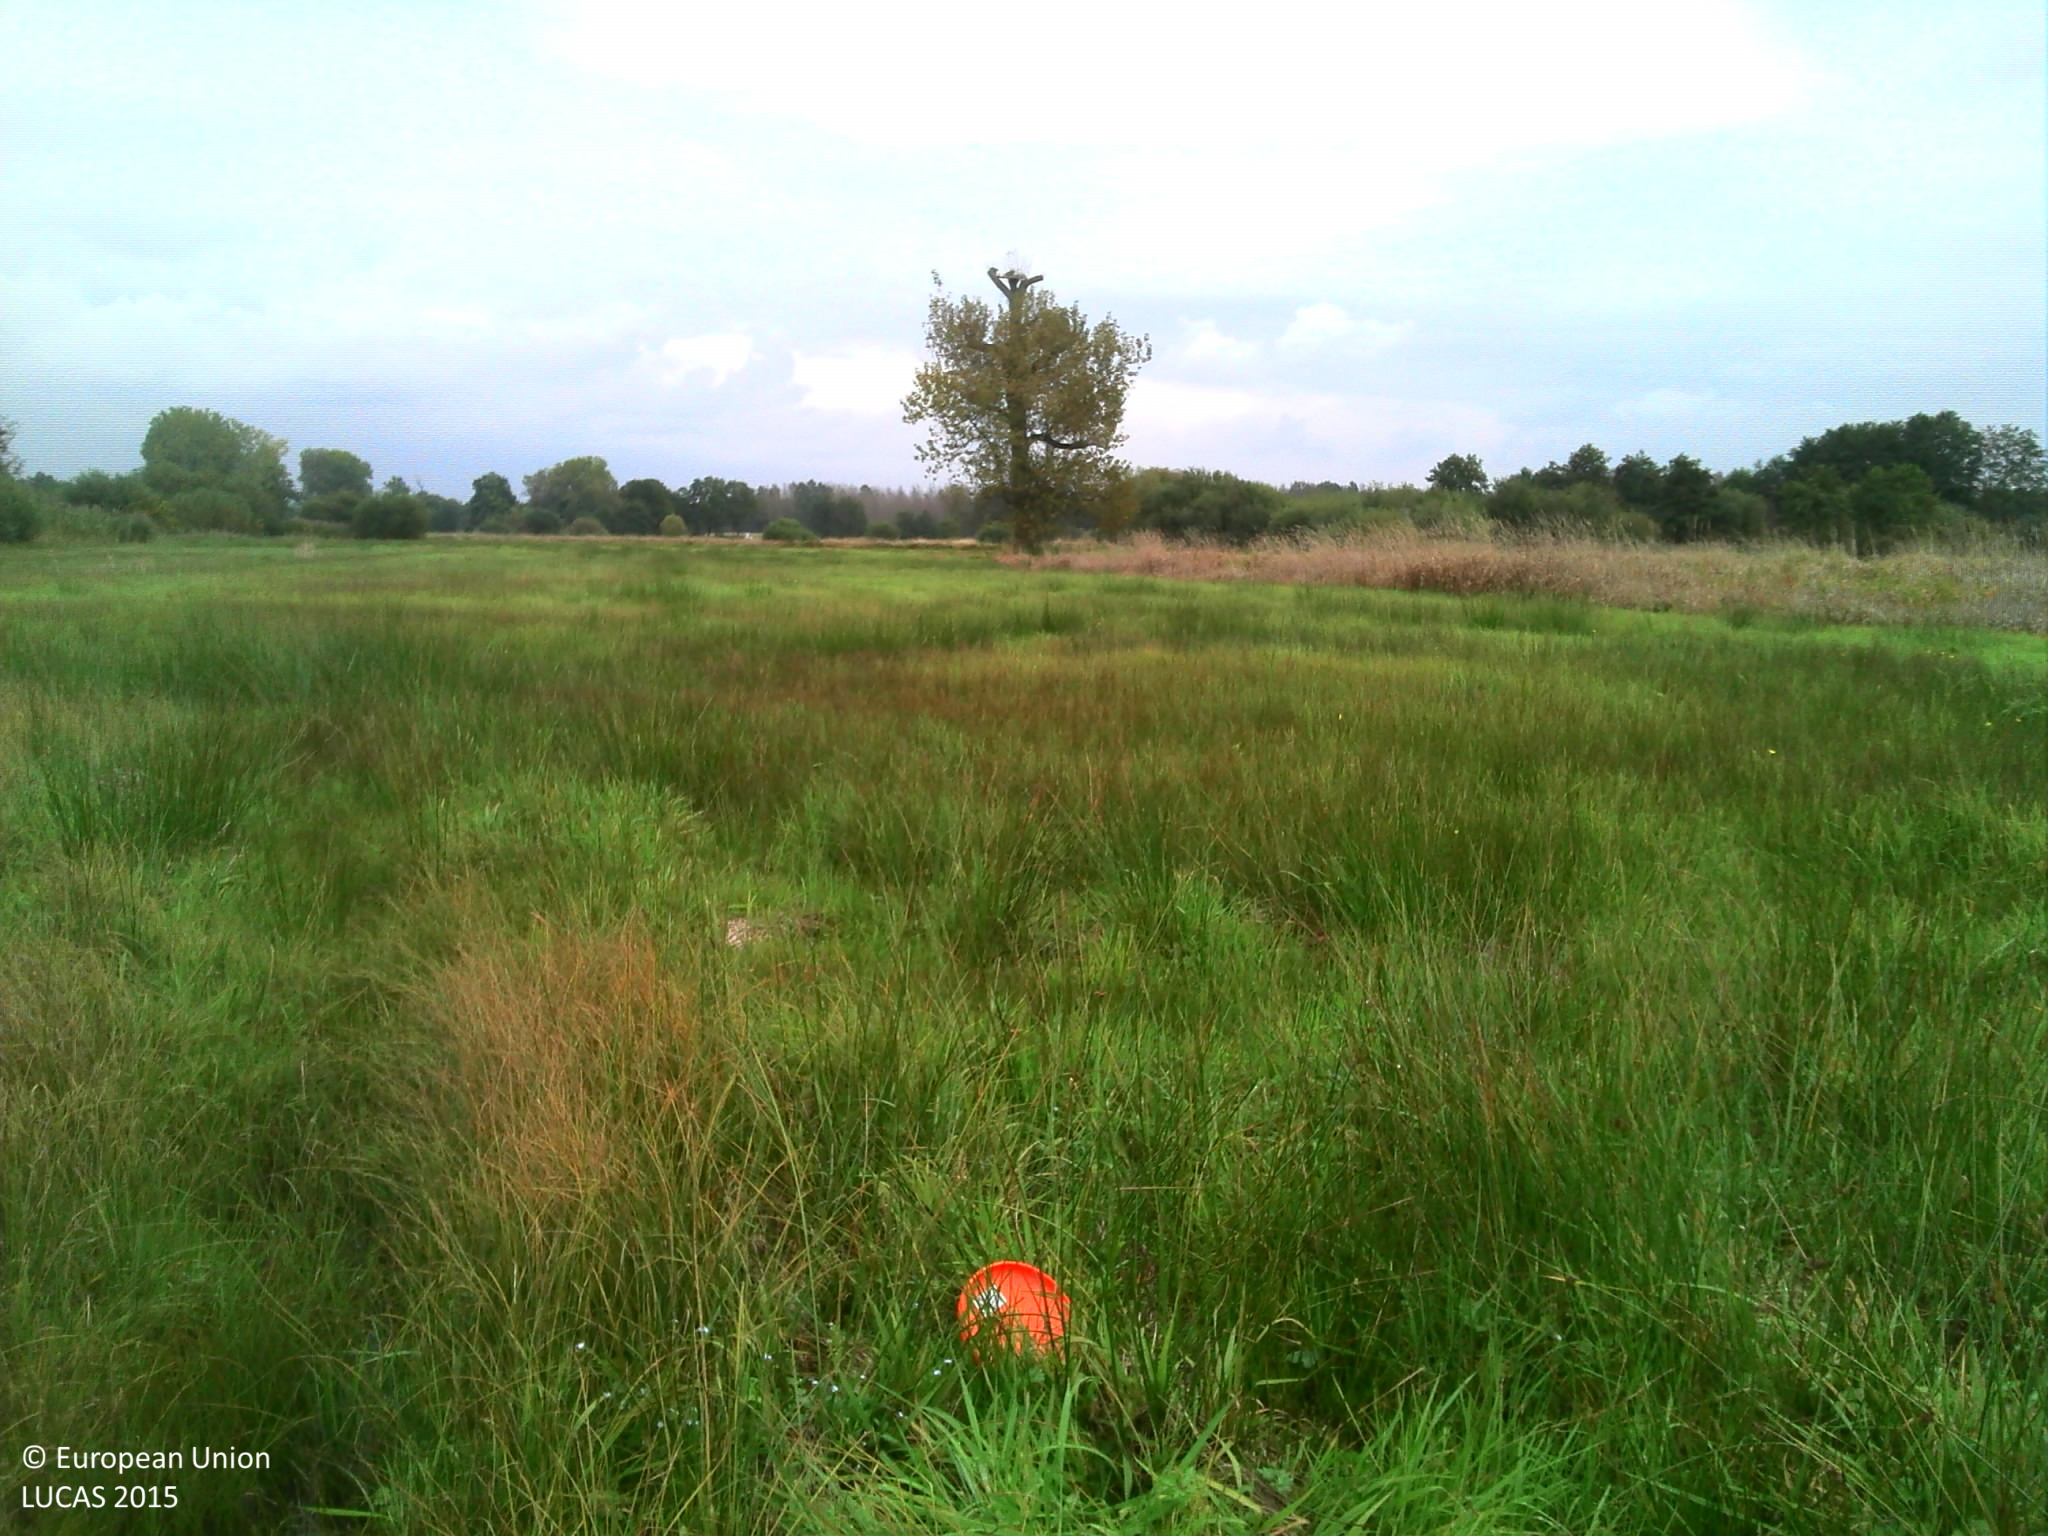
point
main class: Grassland
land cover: Grassland without tree/shrub cover
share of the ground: > 75 %
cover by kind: herbaceous plants 100 %
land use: Agriculture (excluding fallow land and kitchen gardens)
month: October
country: BE
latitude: 51.1451
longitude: 5.1803
